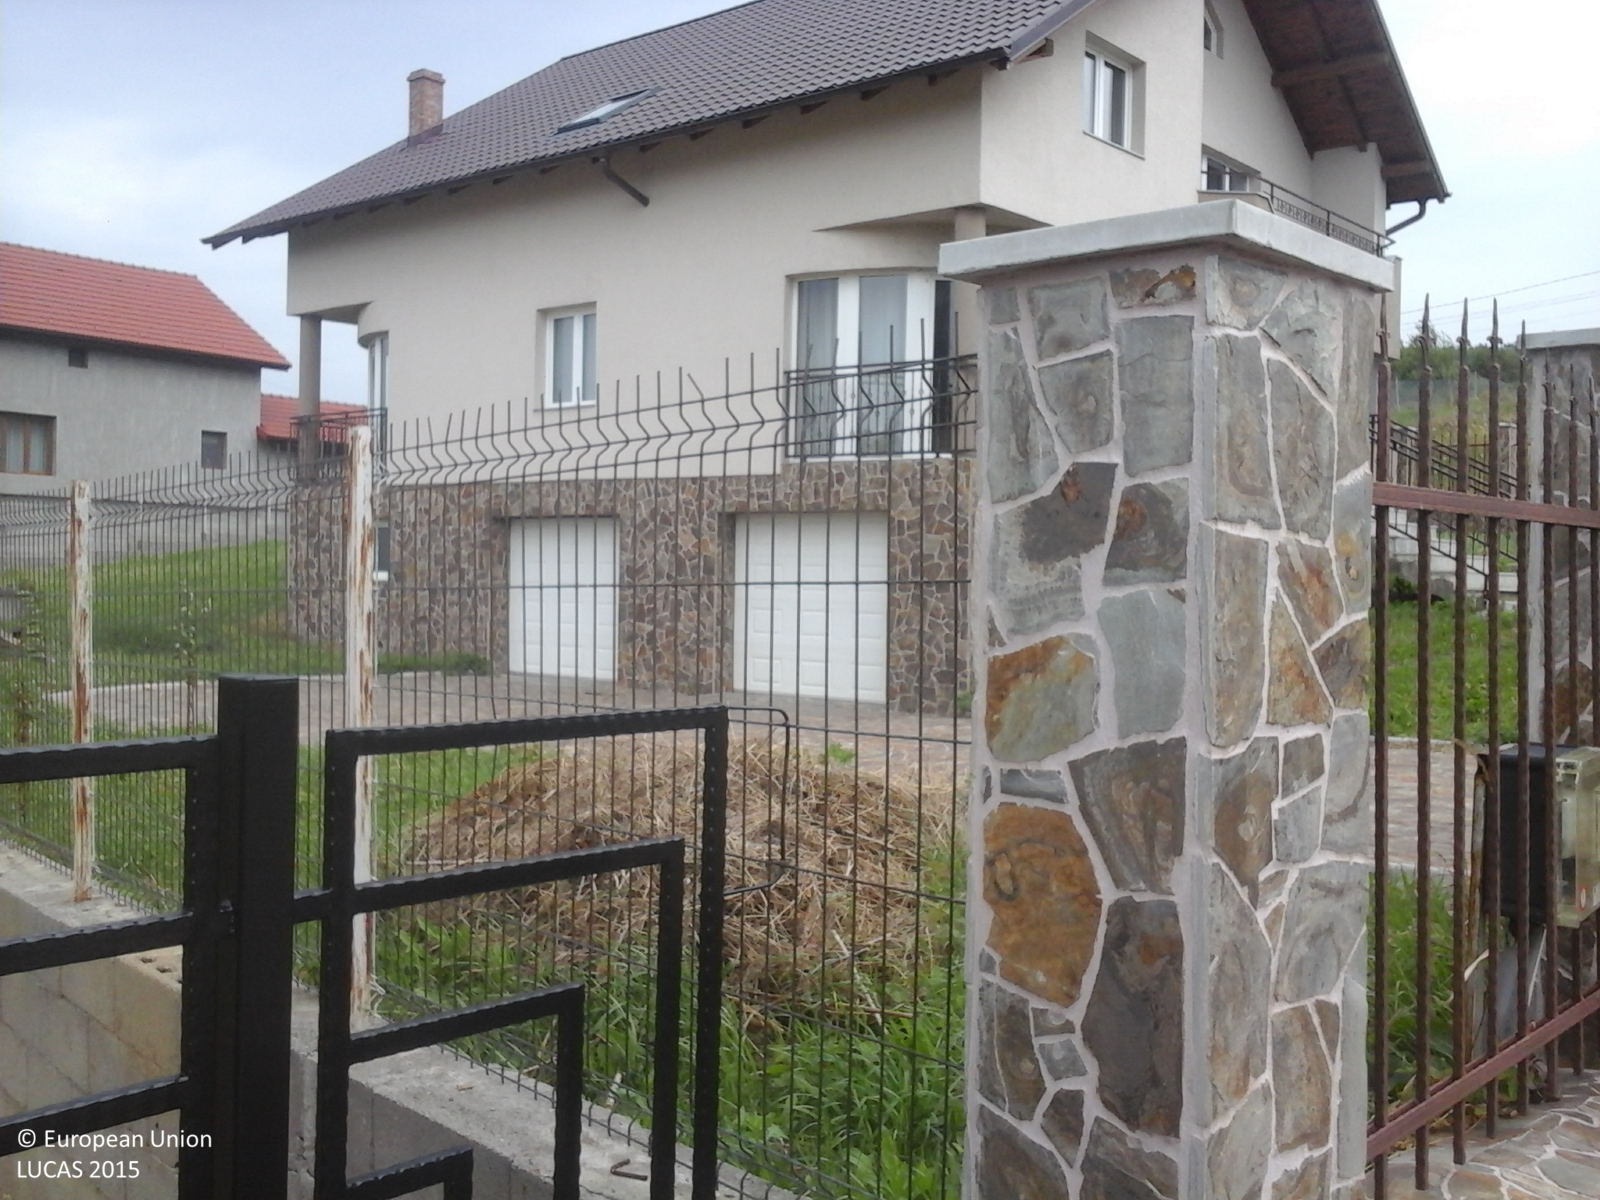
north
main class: Cropland
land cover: Other fruit trees and berries
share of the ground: 25 - 50 %
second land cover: Grassland without tree/shrub cover
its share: > 75 %
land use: Agriculture (excluding fallow land and kitchen gardens)
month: September
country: RO
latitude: 47.1838
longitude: 23.0896
